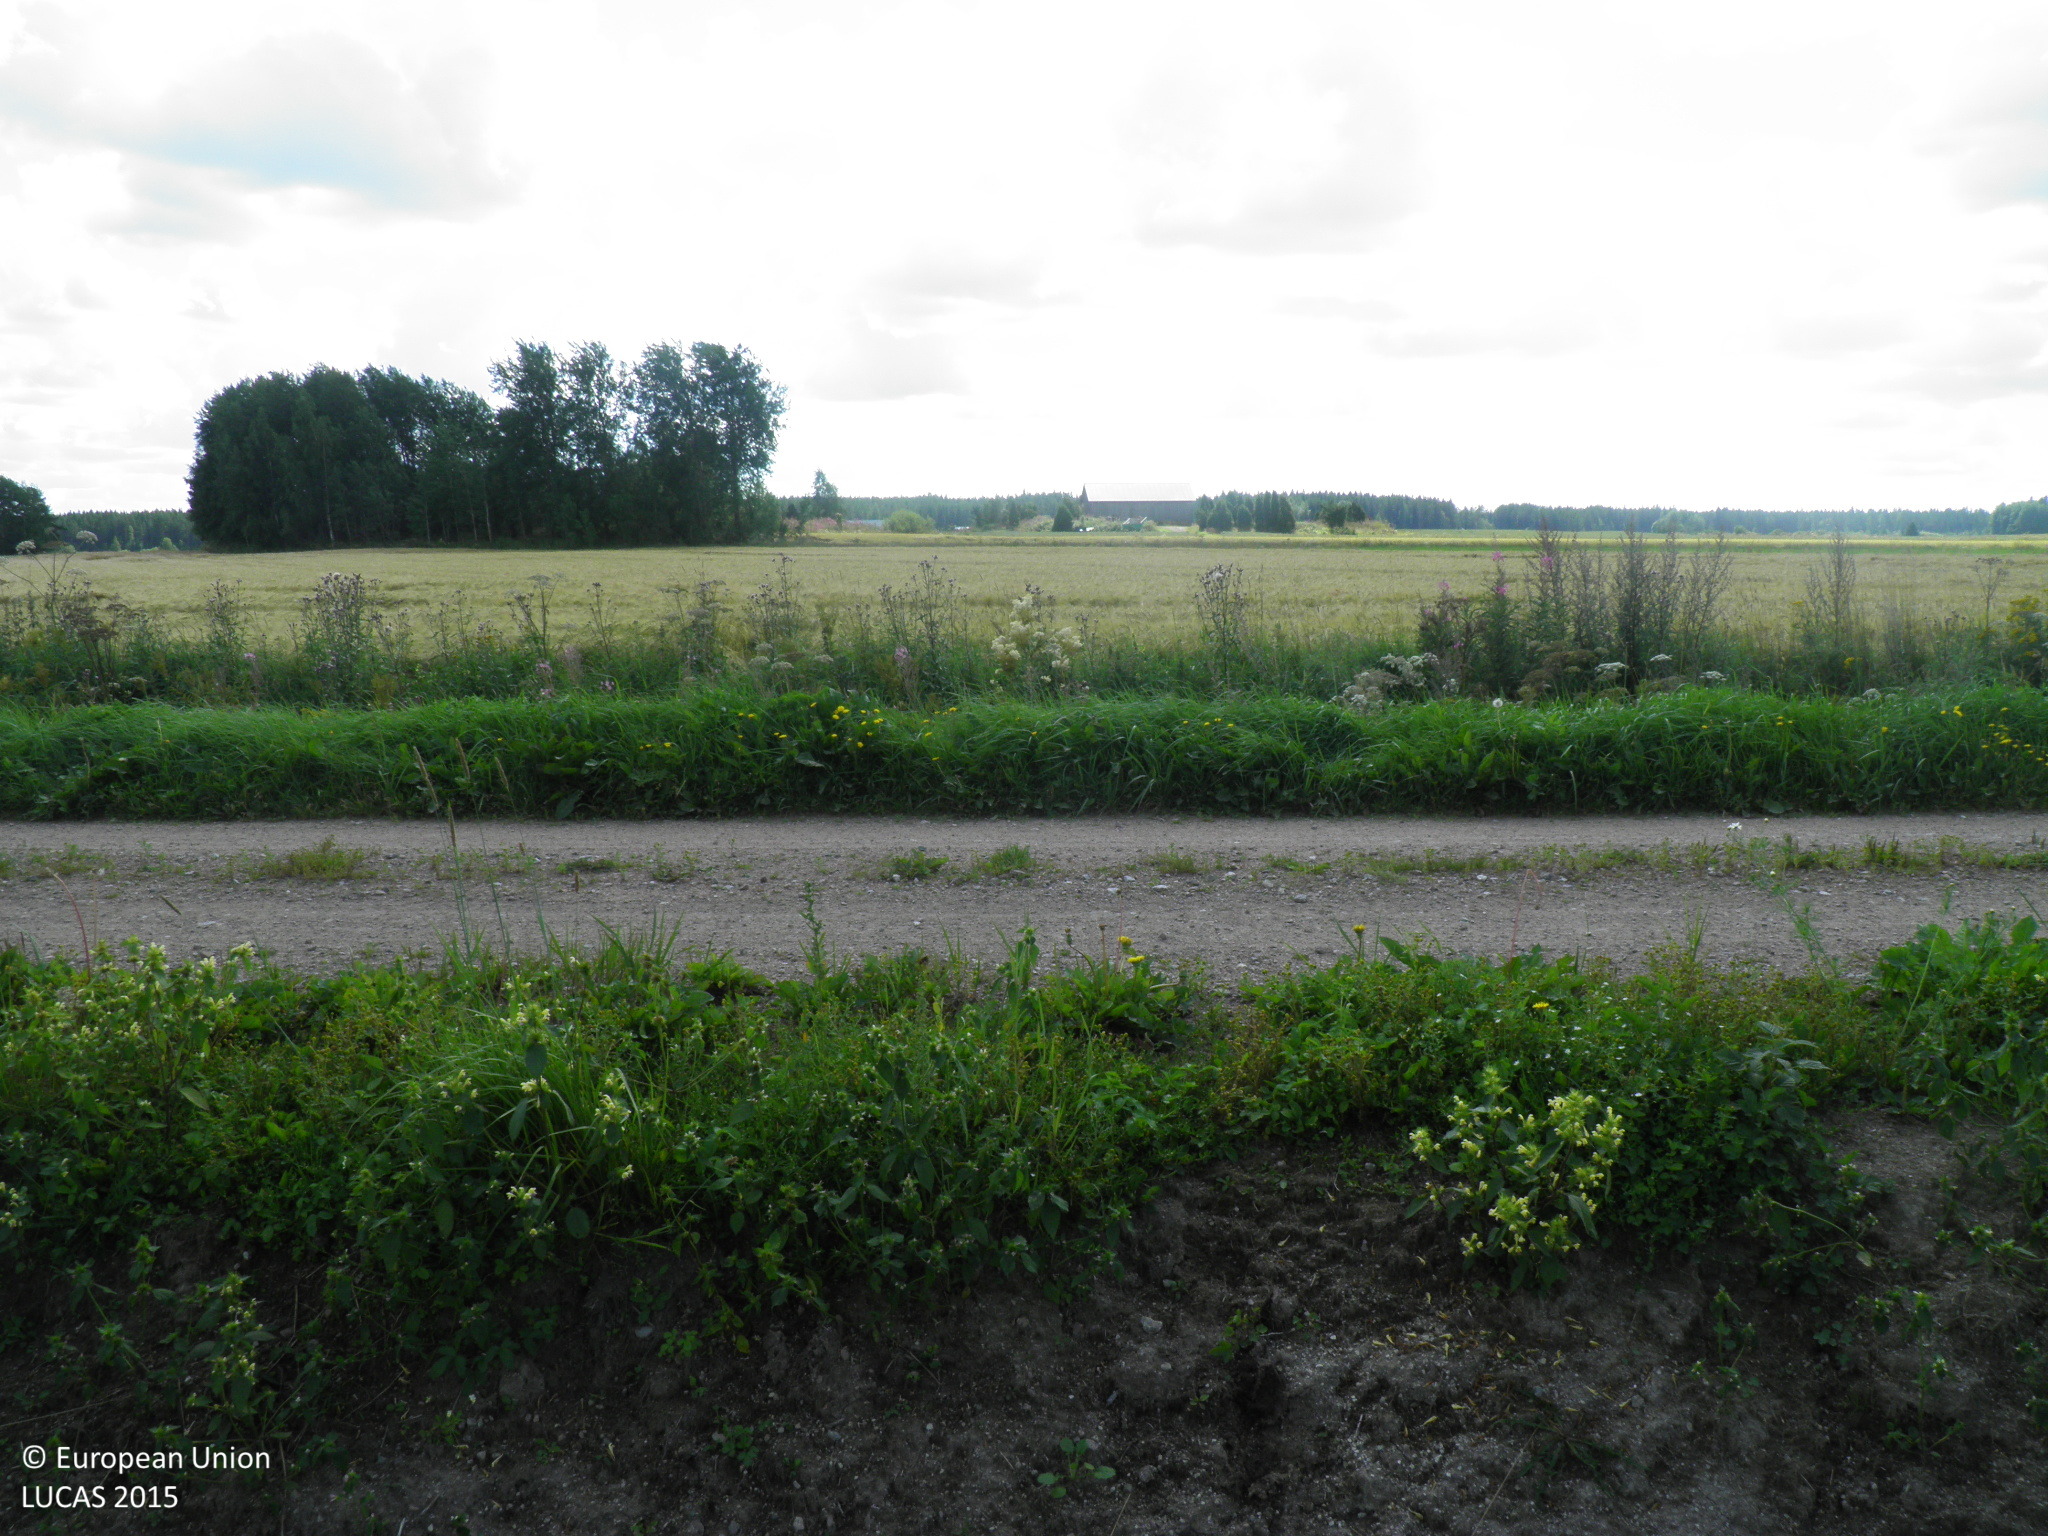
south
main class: Cropland
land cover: Dry pulses
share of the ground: > 75 %
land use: Agriculture (excluding fallow land and kitchen gardens)
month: August
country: FI
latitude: 61.0347
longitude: 21.9993
